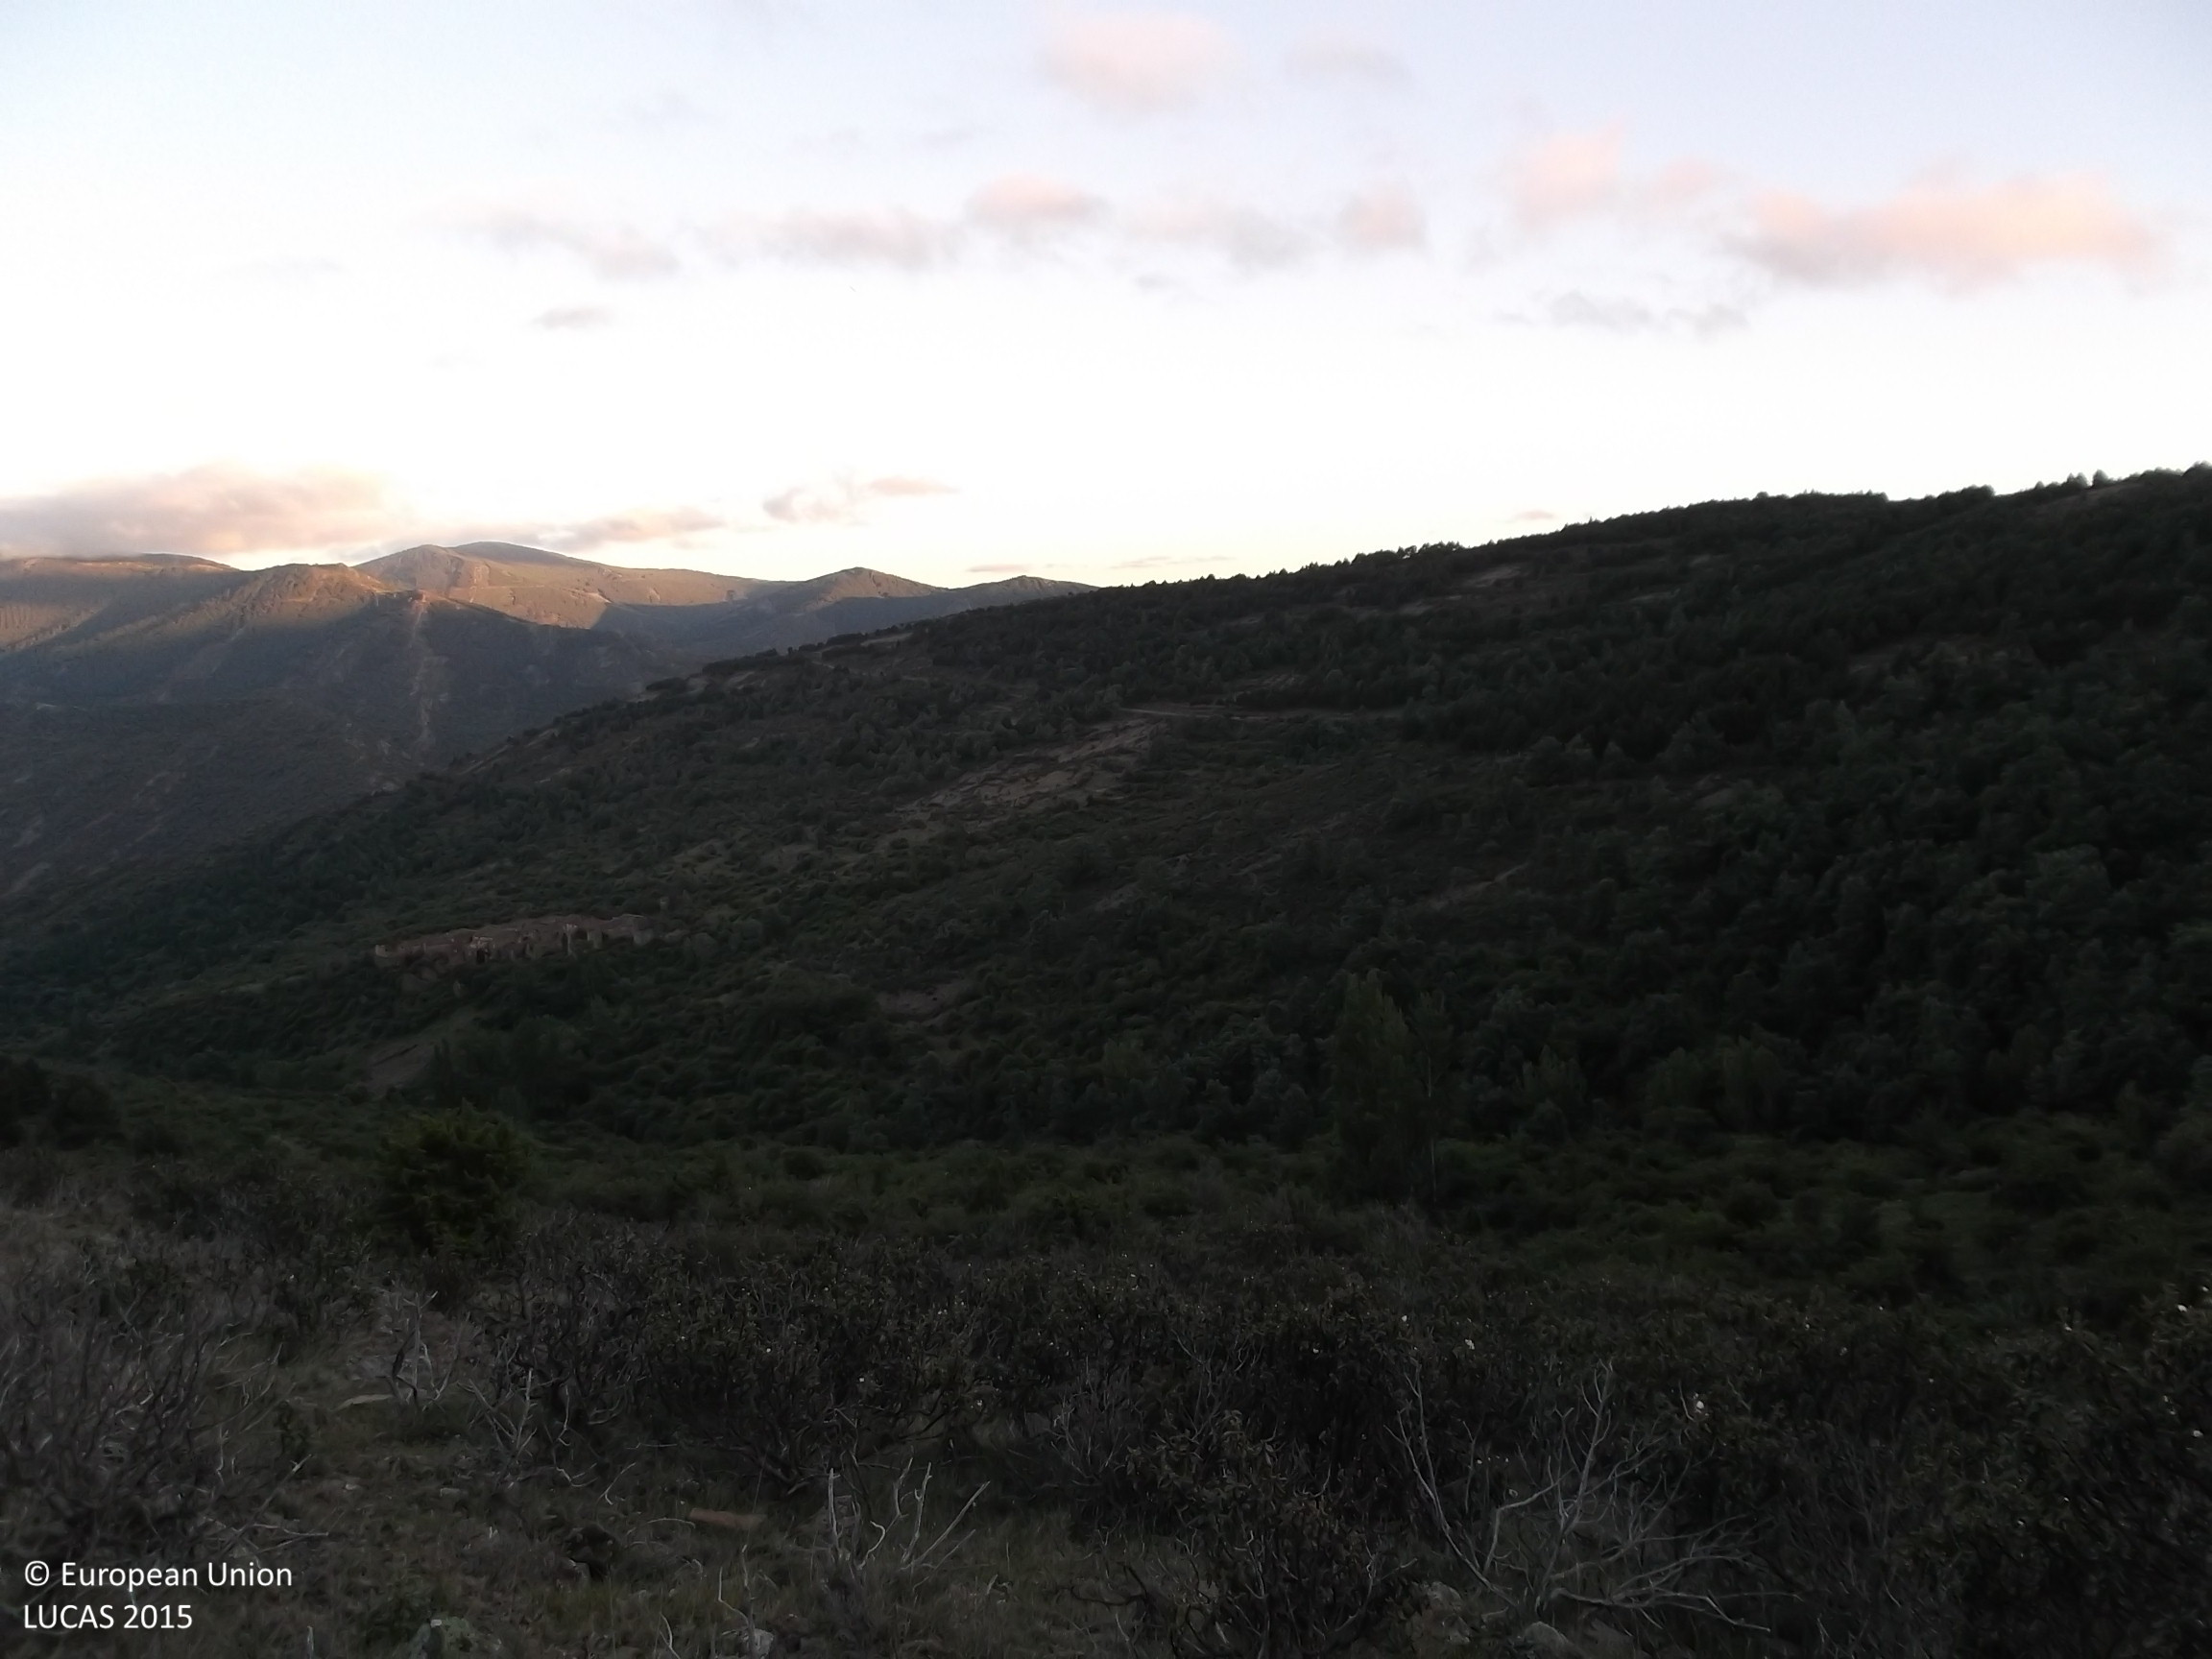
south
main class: Shrubland
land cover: Shrubland with sparse tree cover
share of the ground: 50 - 75 %
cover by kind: shrubs 60 %, herbaceous plants 20 %, unconsolidated bare surface 15 %, broadleaved forest trees 5 %
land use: Semi-natural and natural areas not in use
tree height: < 5 m
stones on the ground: > 50 %
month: June
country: ES
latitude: 42.1360
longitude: -2.3201
